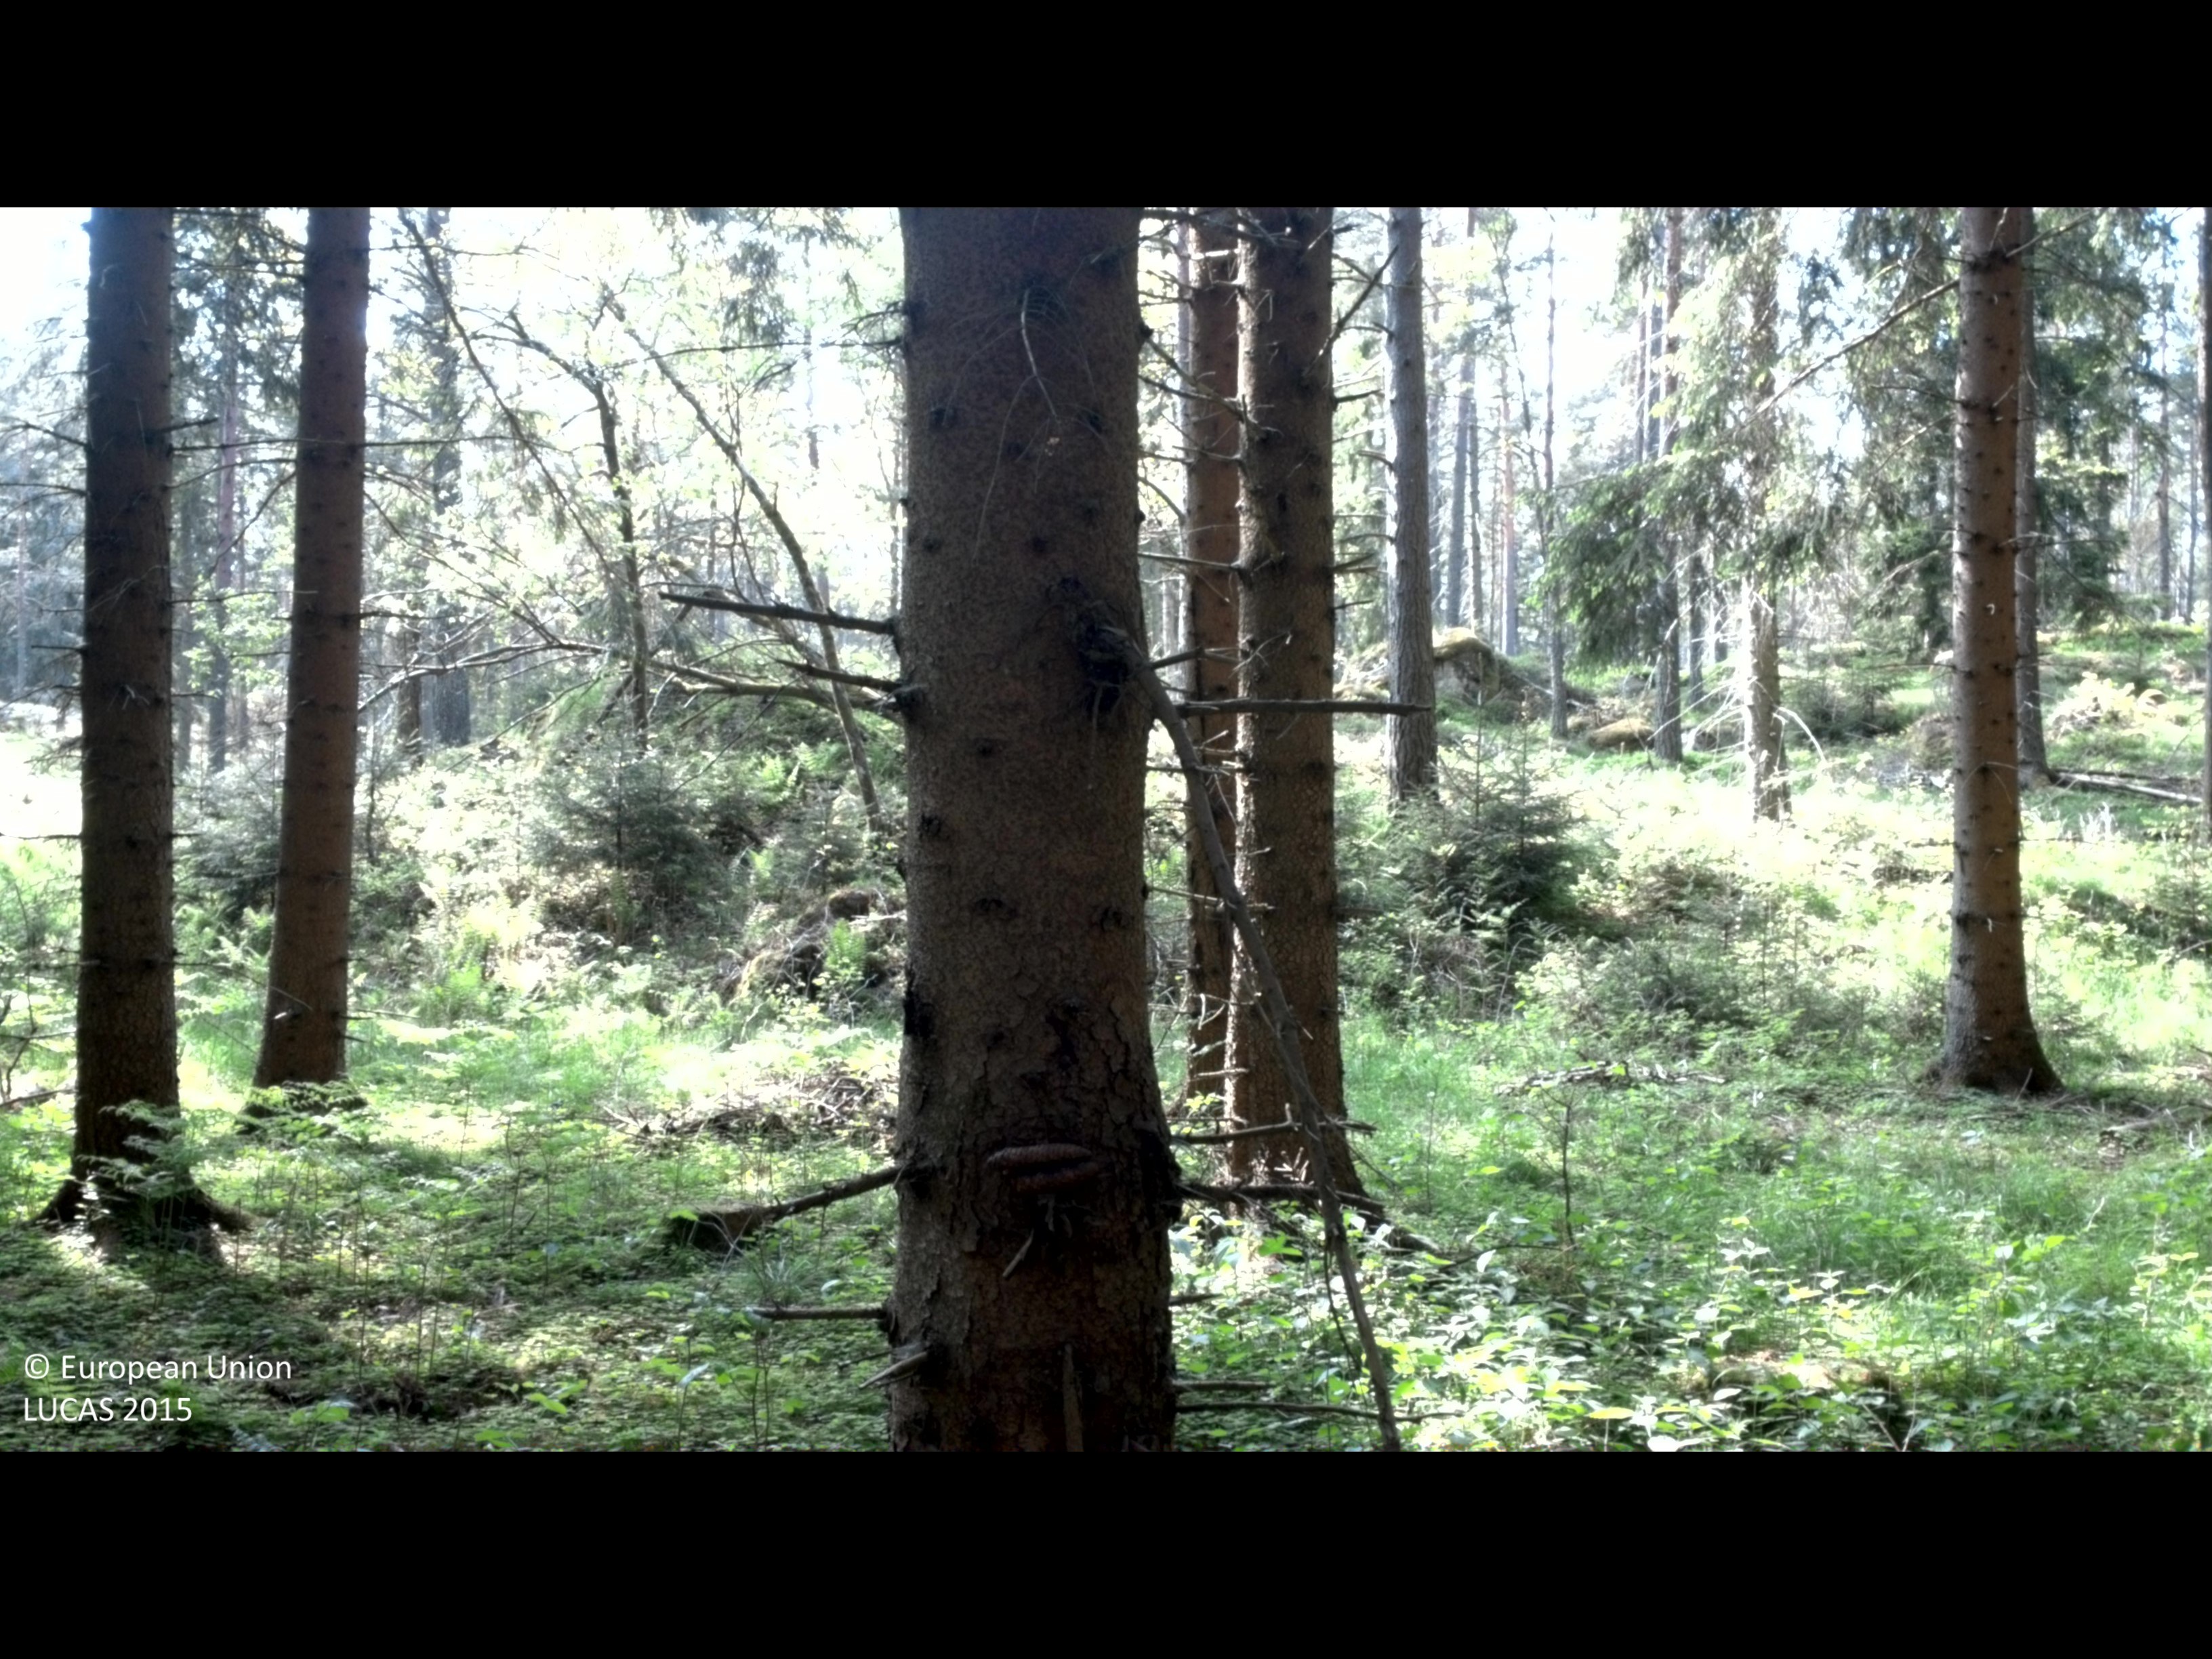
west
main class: Woodland
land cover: Spruce dominated coniferous woodland
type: boreal forest
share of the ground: > 75 %
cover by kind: coniferous forest trees 95 %, herbaceous plants 5 %
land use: Forestry
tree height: > 5 m
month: May
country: SE
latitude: 57.4087
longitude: 16.5747
